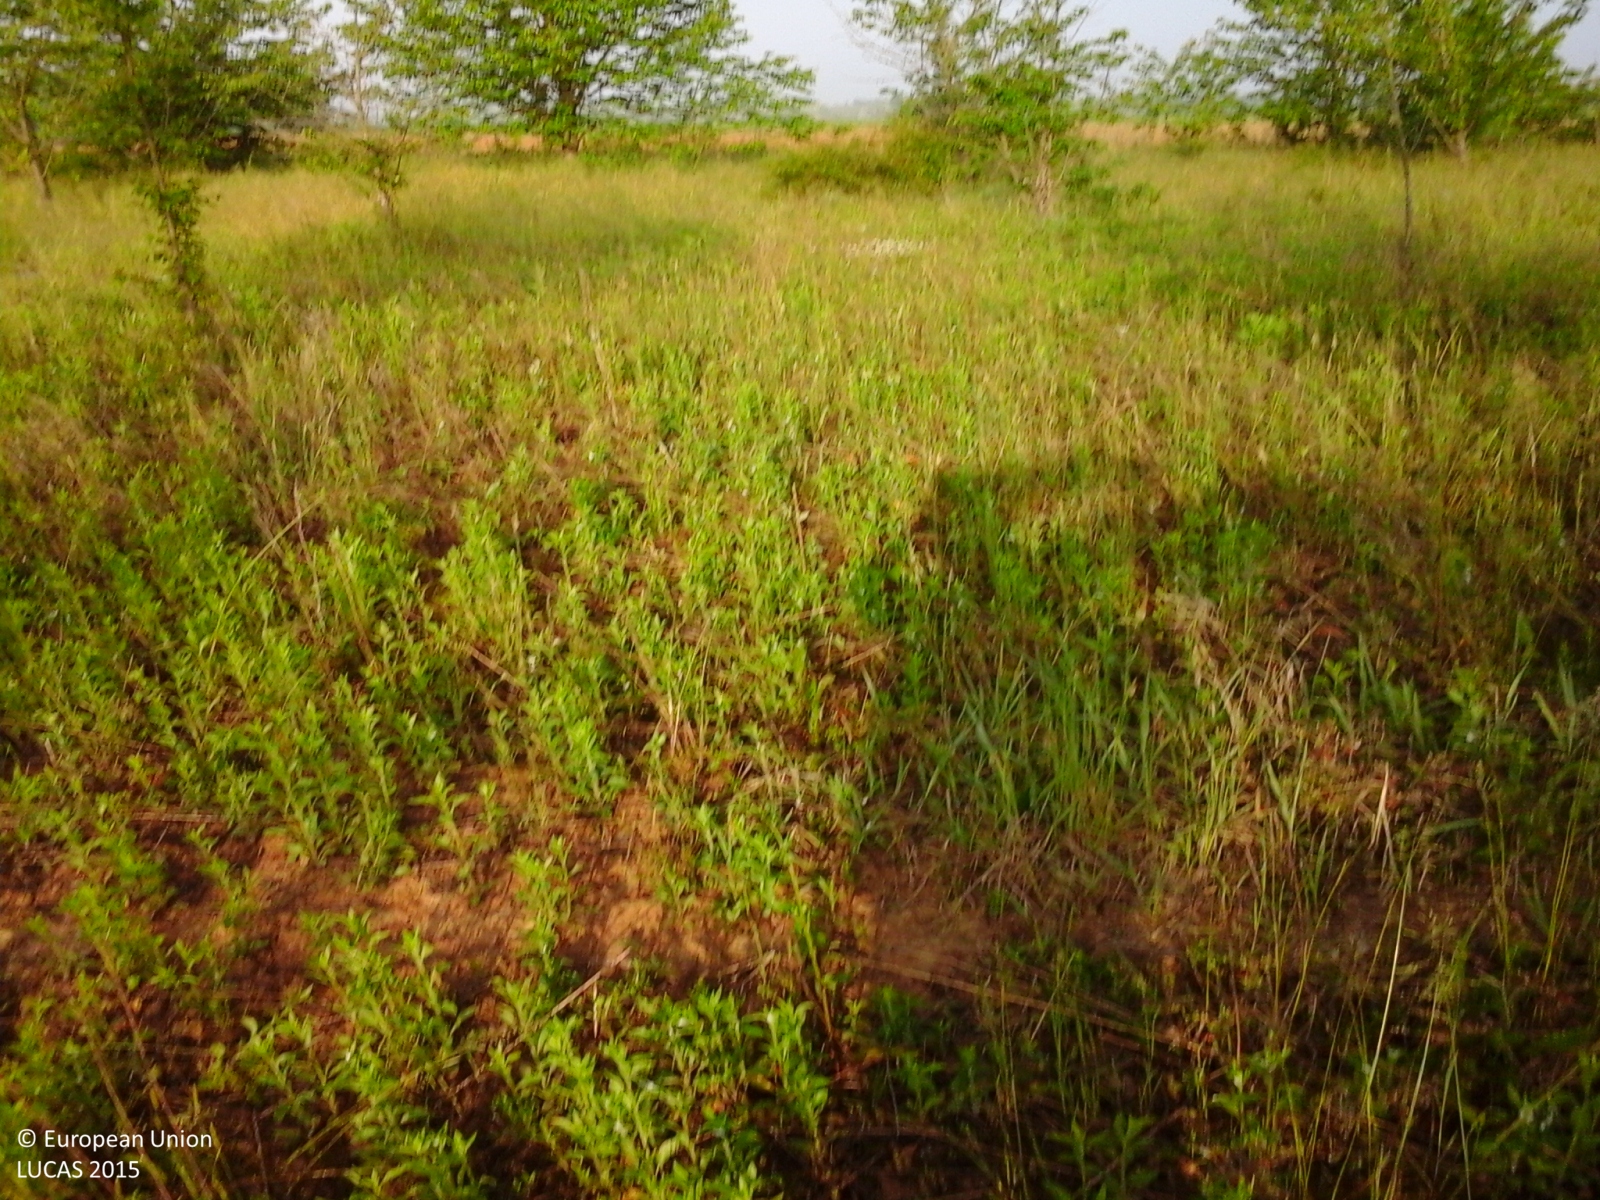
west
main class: Cropland
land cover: Cherry fruit
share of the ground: 10 - 25 %
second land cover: Spontaneously vegetated surfaces
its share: > 75 %
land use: Abandoned areas
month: May
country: IT
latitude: 44.9341
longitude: 8.4444
